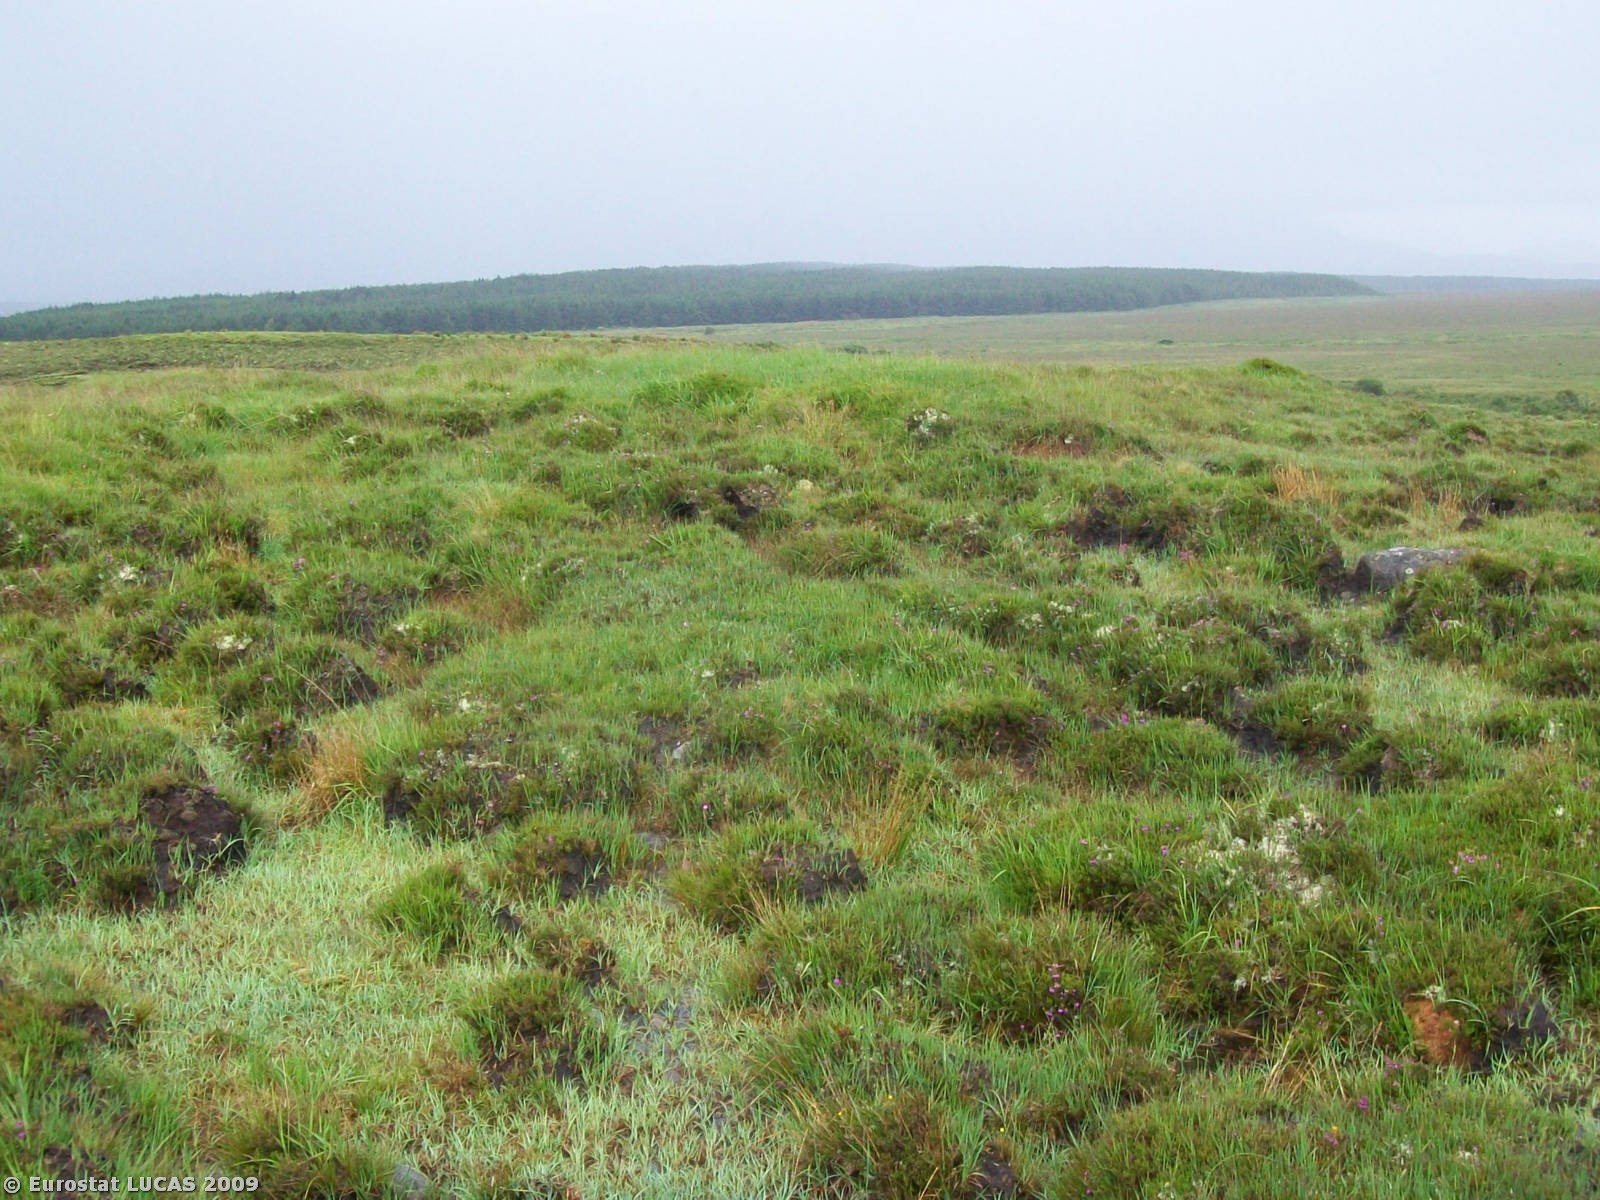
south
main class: Wetlands
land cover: Peatbogs
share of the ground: > 75 %
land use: Unused
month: July
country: IE
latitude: 54.0078
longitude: -9.7901
